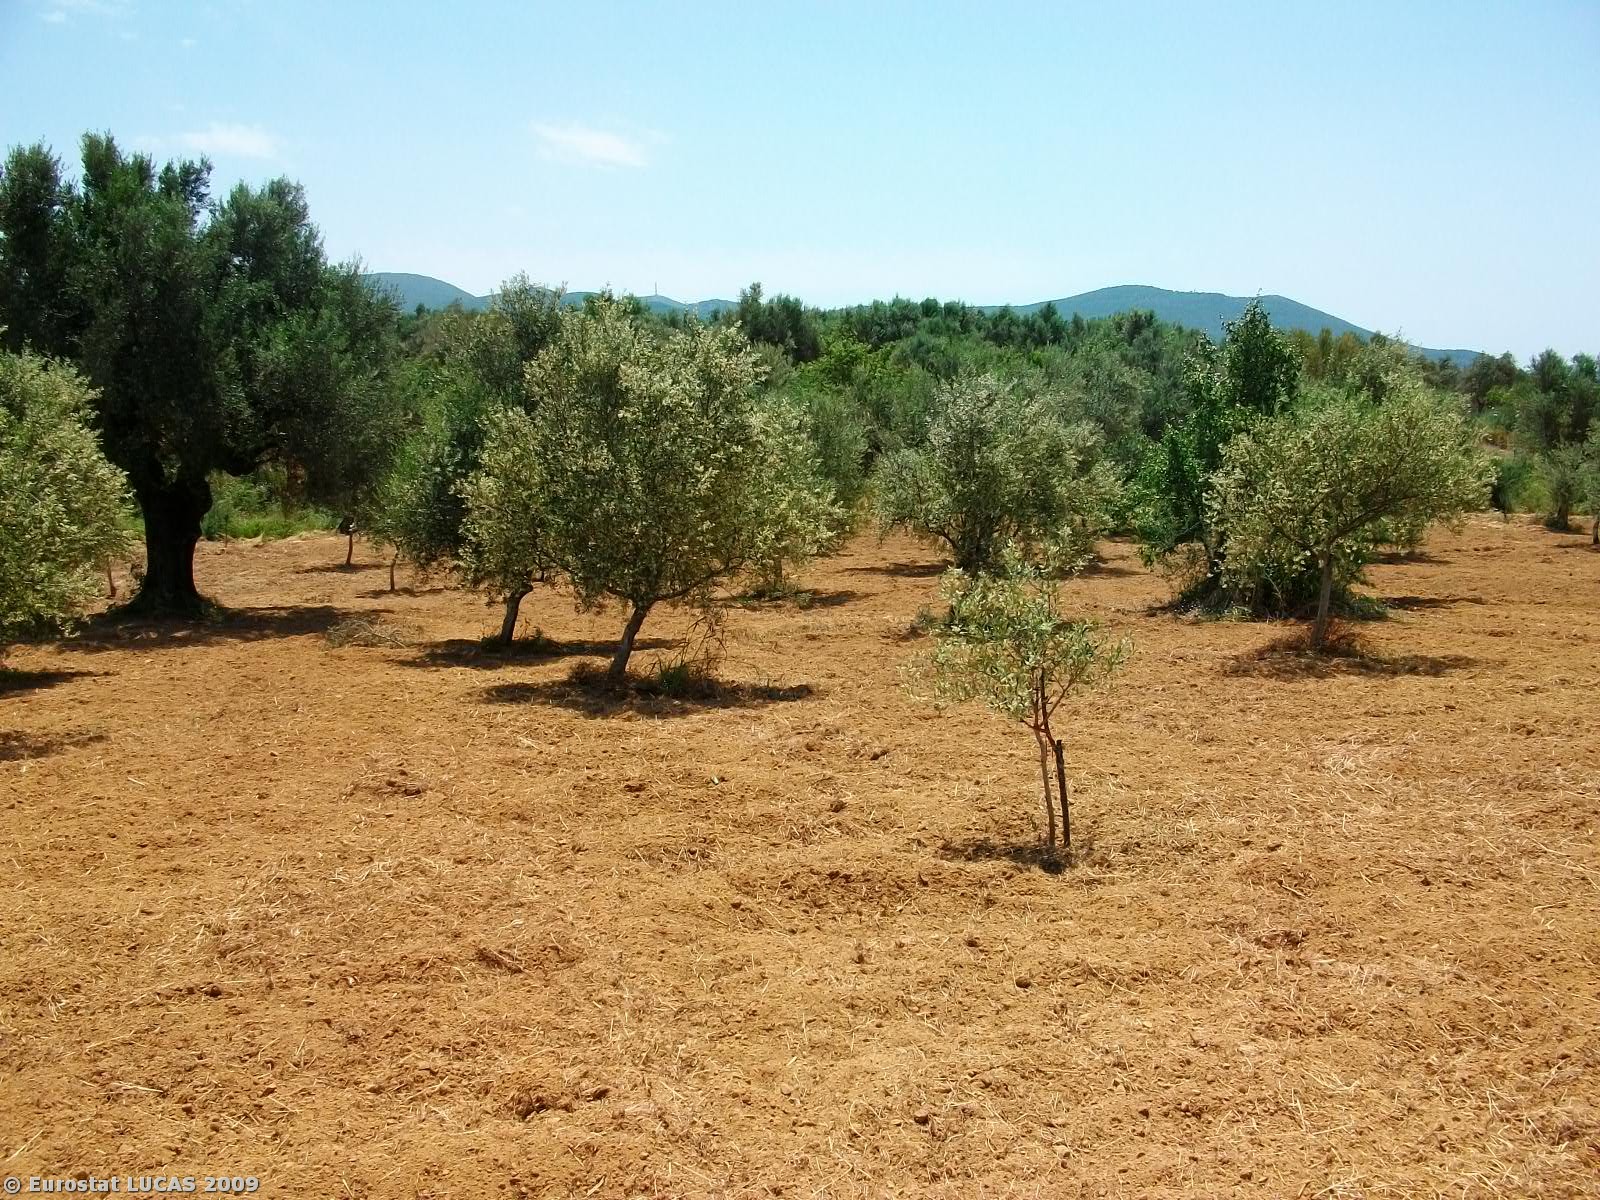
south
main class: Cropland
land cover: Olive groves
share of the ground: 25 - 50 %
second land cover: Bare land
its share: > 75 %
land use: Agriculture (excluding fallow land and kitchen gardens)
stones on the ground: < 10 %
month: May
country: GR
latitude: 37.2375
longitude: 22.0284
